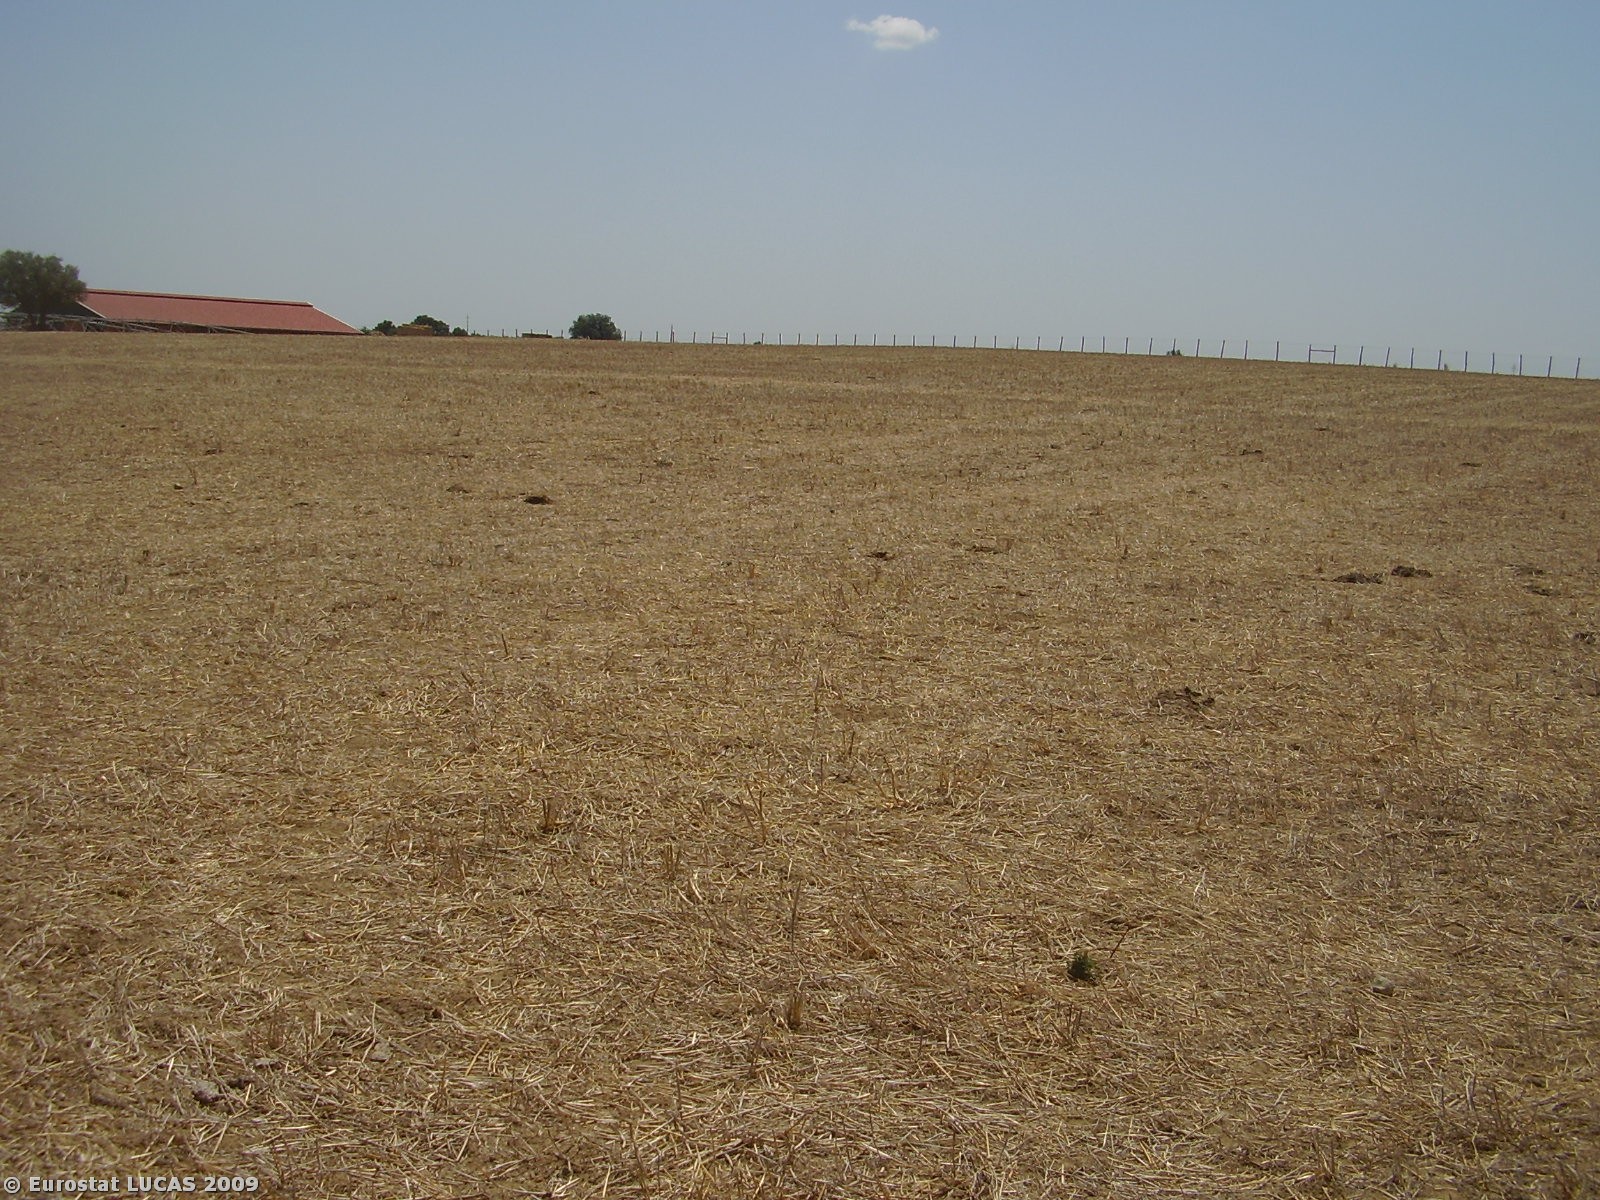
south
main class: Grassland
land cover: Grassland without tree/shrub cover
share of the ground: > 75 %
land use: Fallow land
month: August
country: PT
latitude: 38.1853
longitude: -7.8758
